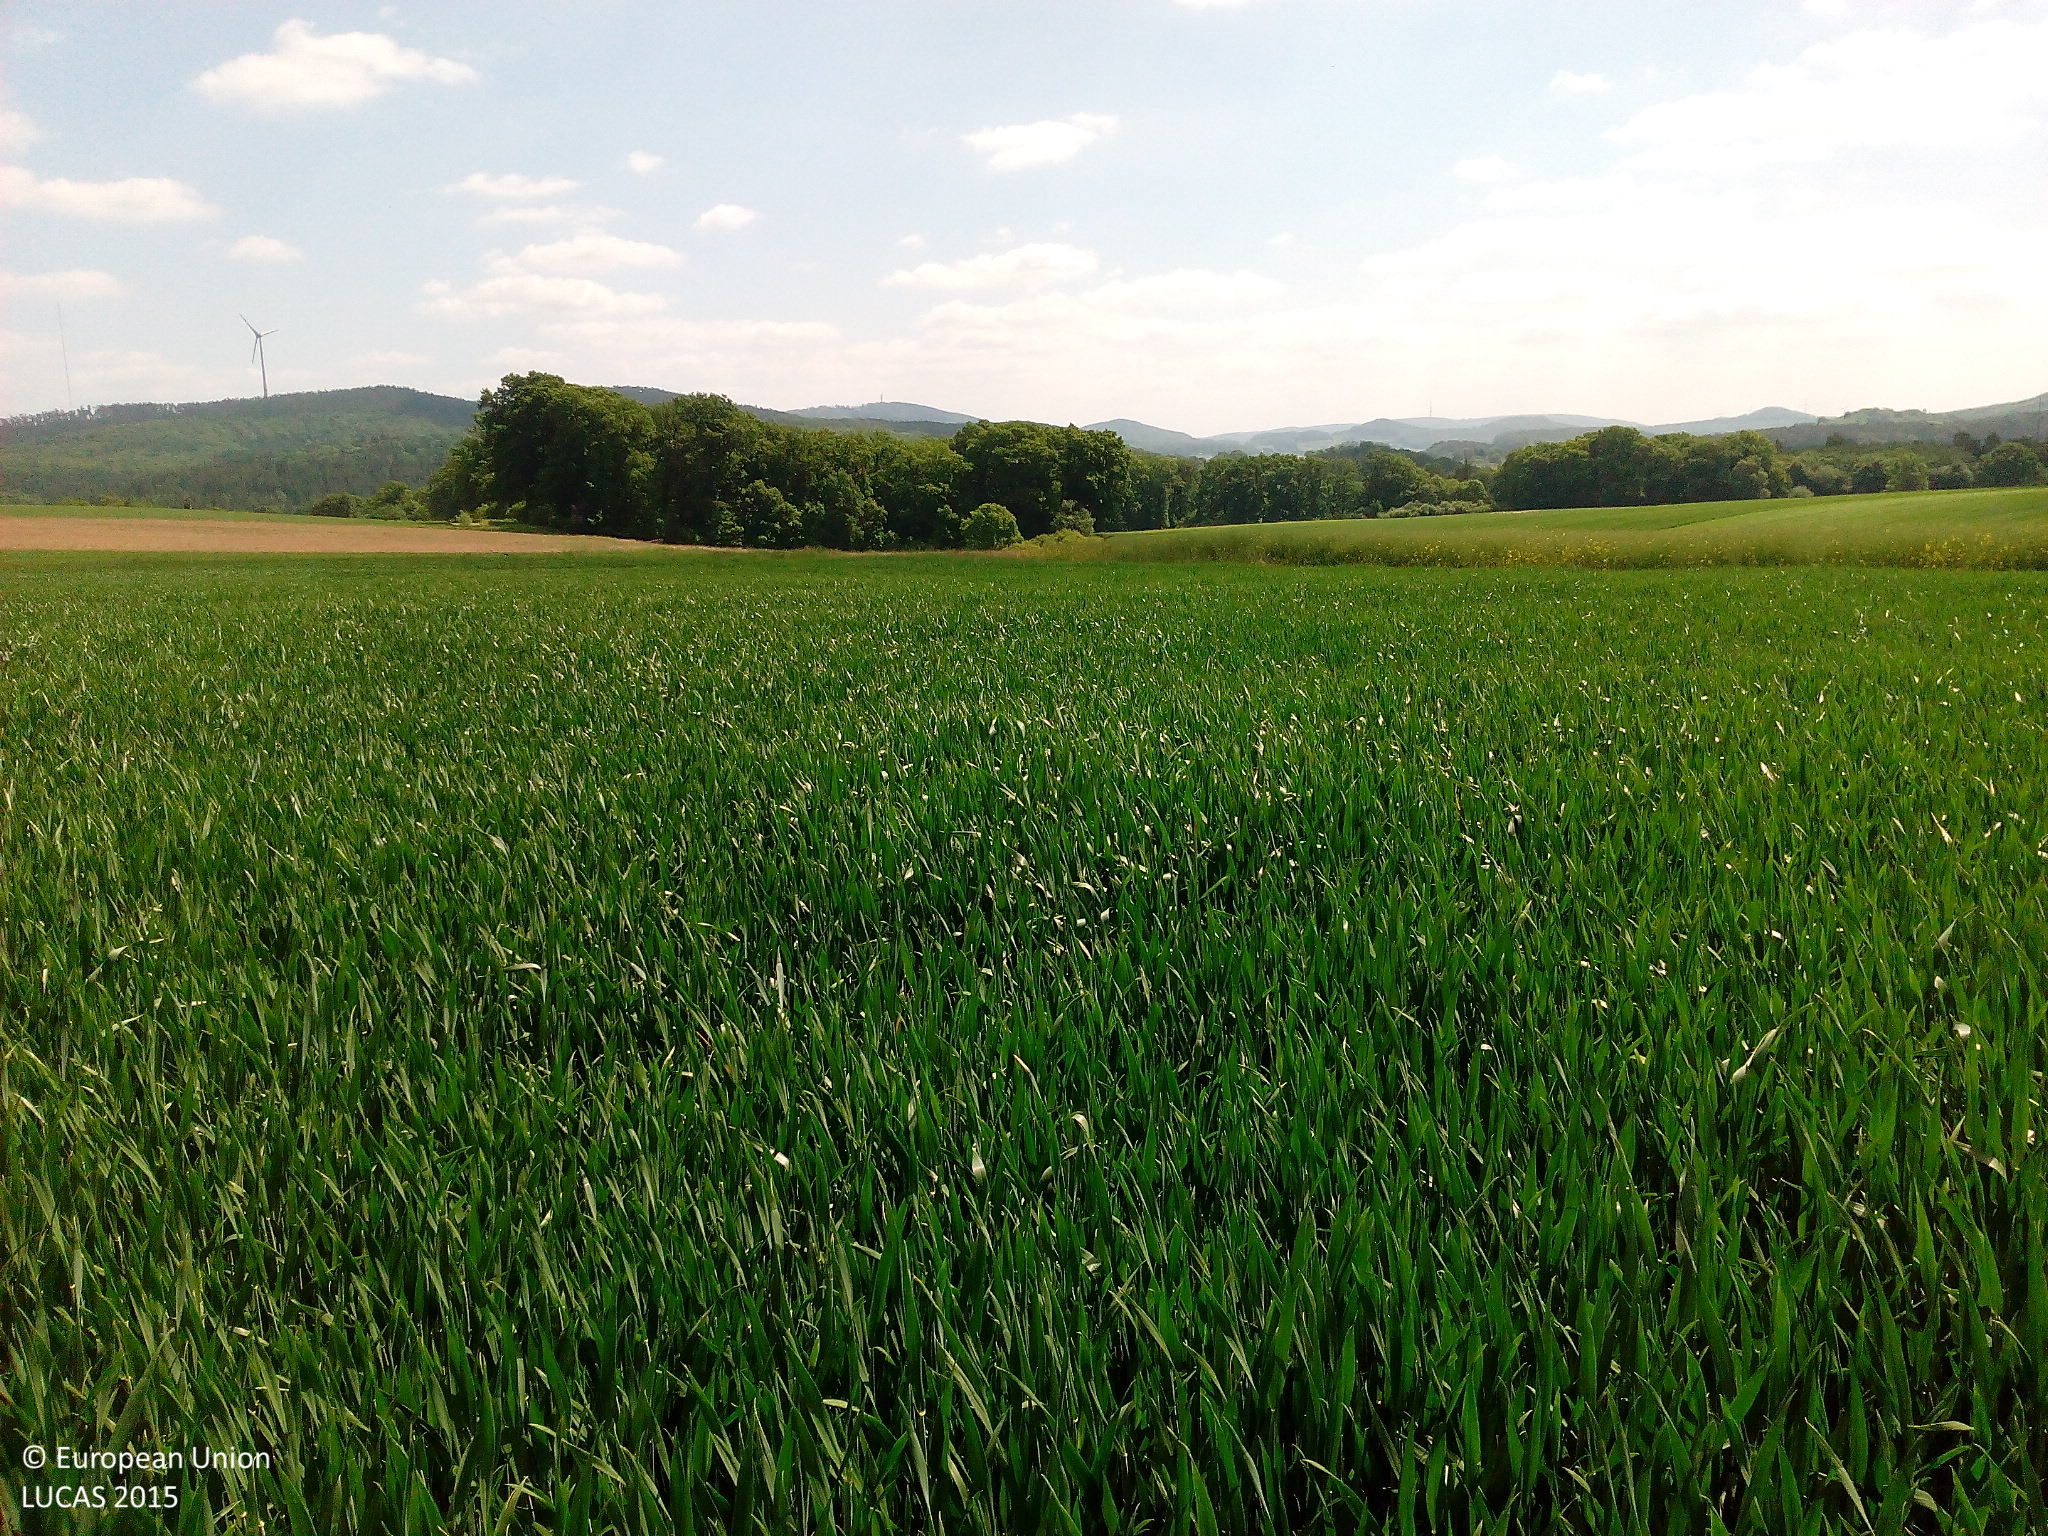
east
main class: Cropland
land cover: Common wheat
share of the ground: > 75 %
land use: Agriculture (excluding fallow land and kitchen gardens)
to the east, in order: Common wheat; Grass margins; Ditches and canals; Grass margins; Tracks; Grassland without tree/shrub cover
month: June
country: DE
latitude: 51.3498
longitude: 9.1531
